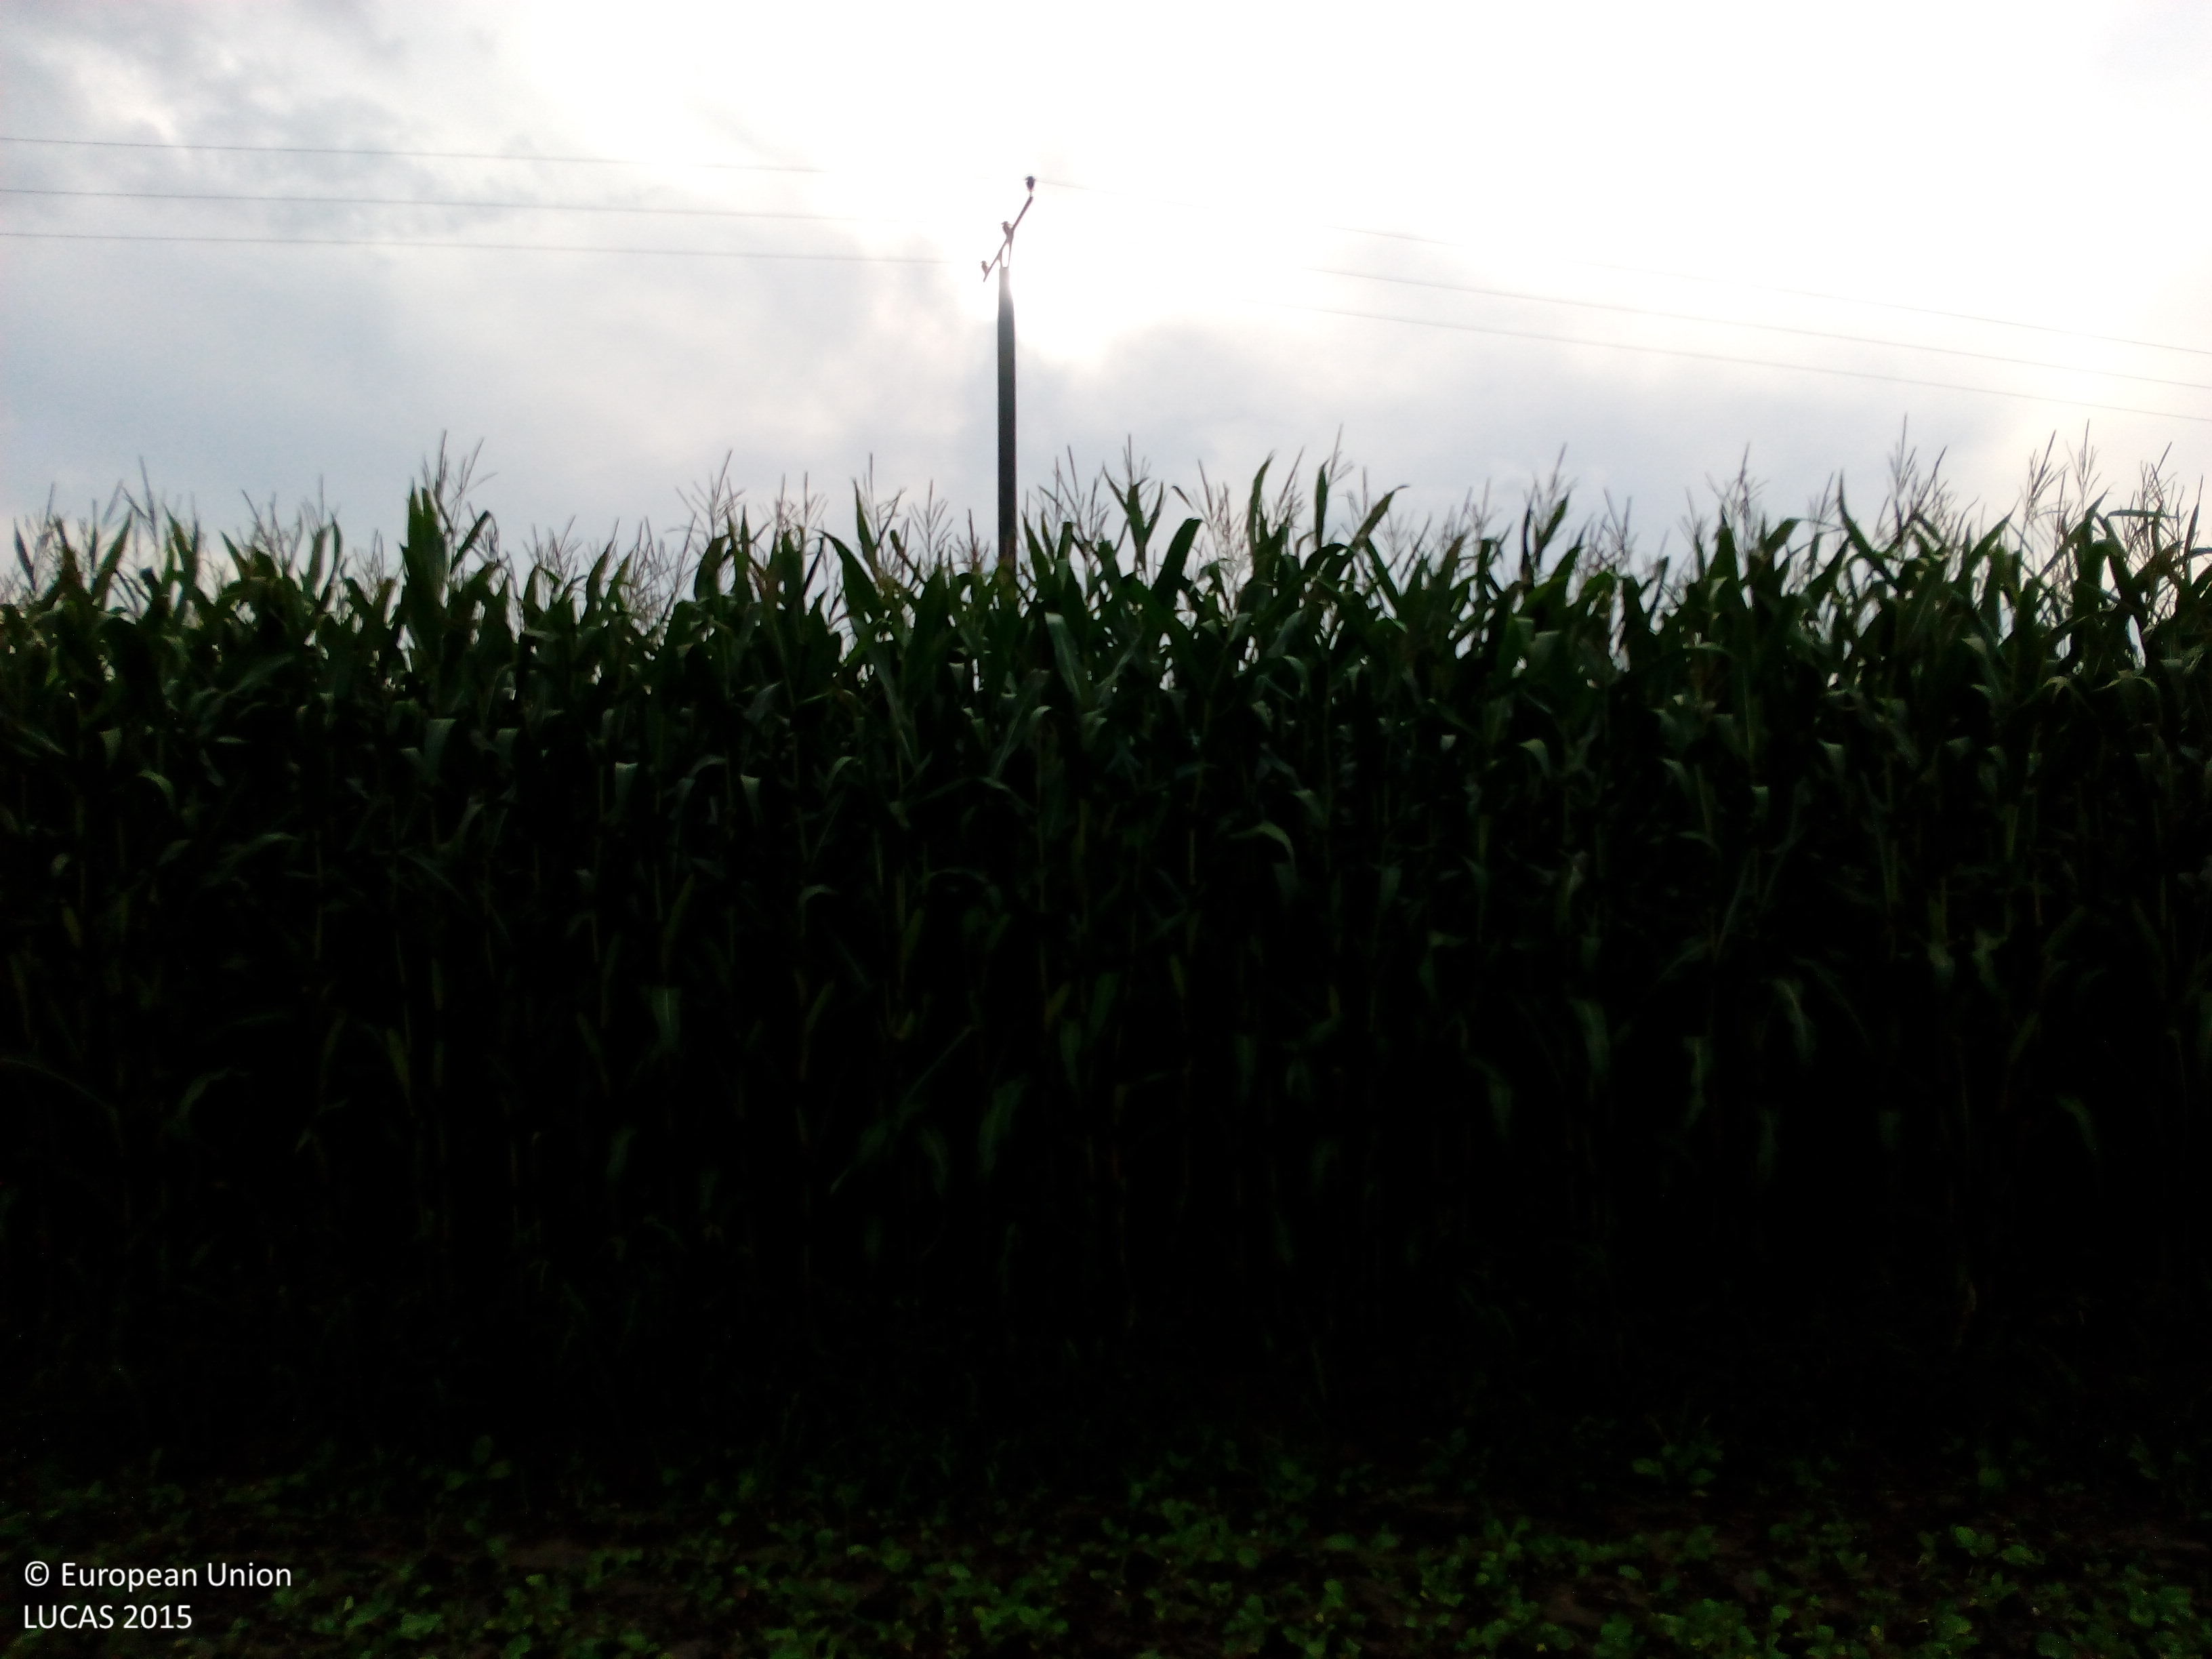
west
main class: Grassland
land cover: Spontaneously vegetated surfaces
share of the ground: > 75 %
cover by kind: herbaceous plants 100 %
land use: Agriculture (excluding fallow land and kitchen gardens)
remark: Harvested field
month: August
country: DE
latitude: 52.4328
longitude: 8.0149
